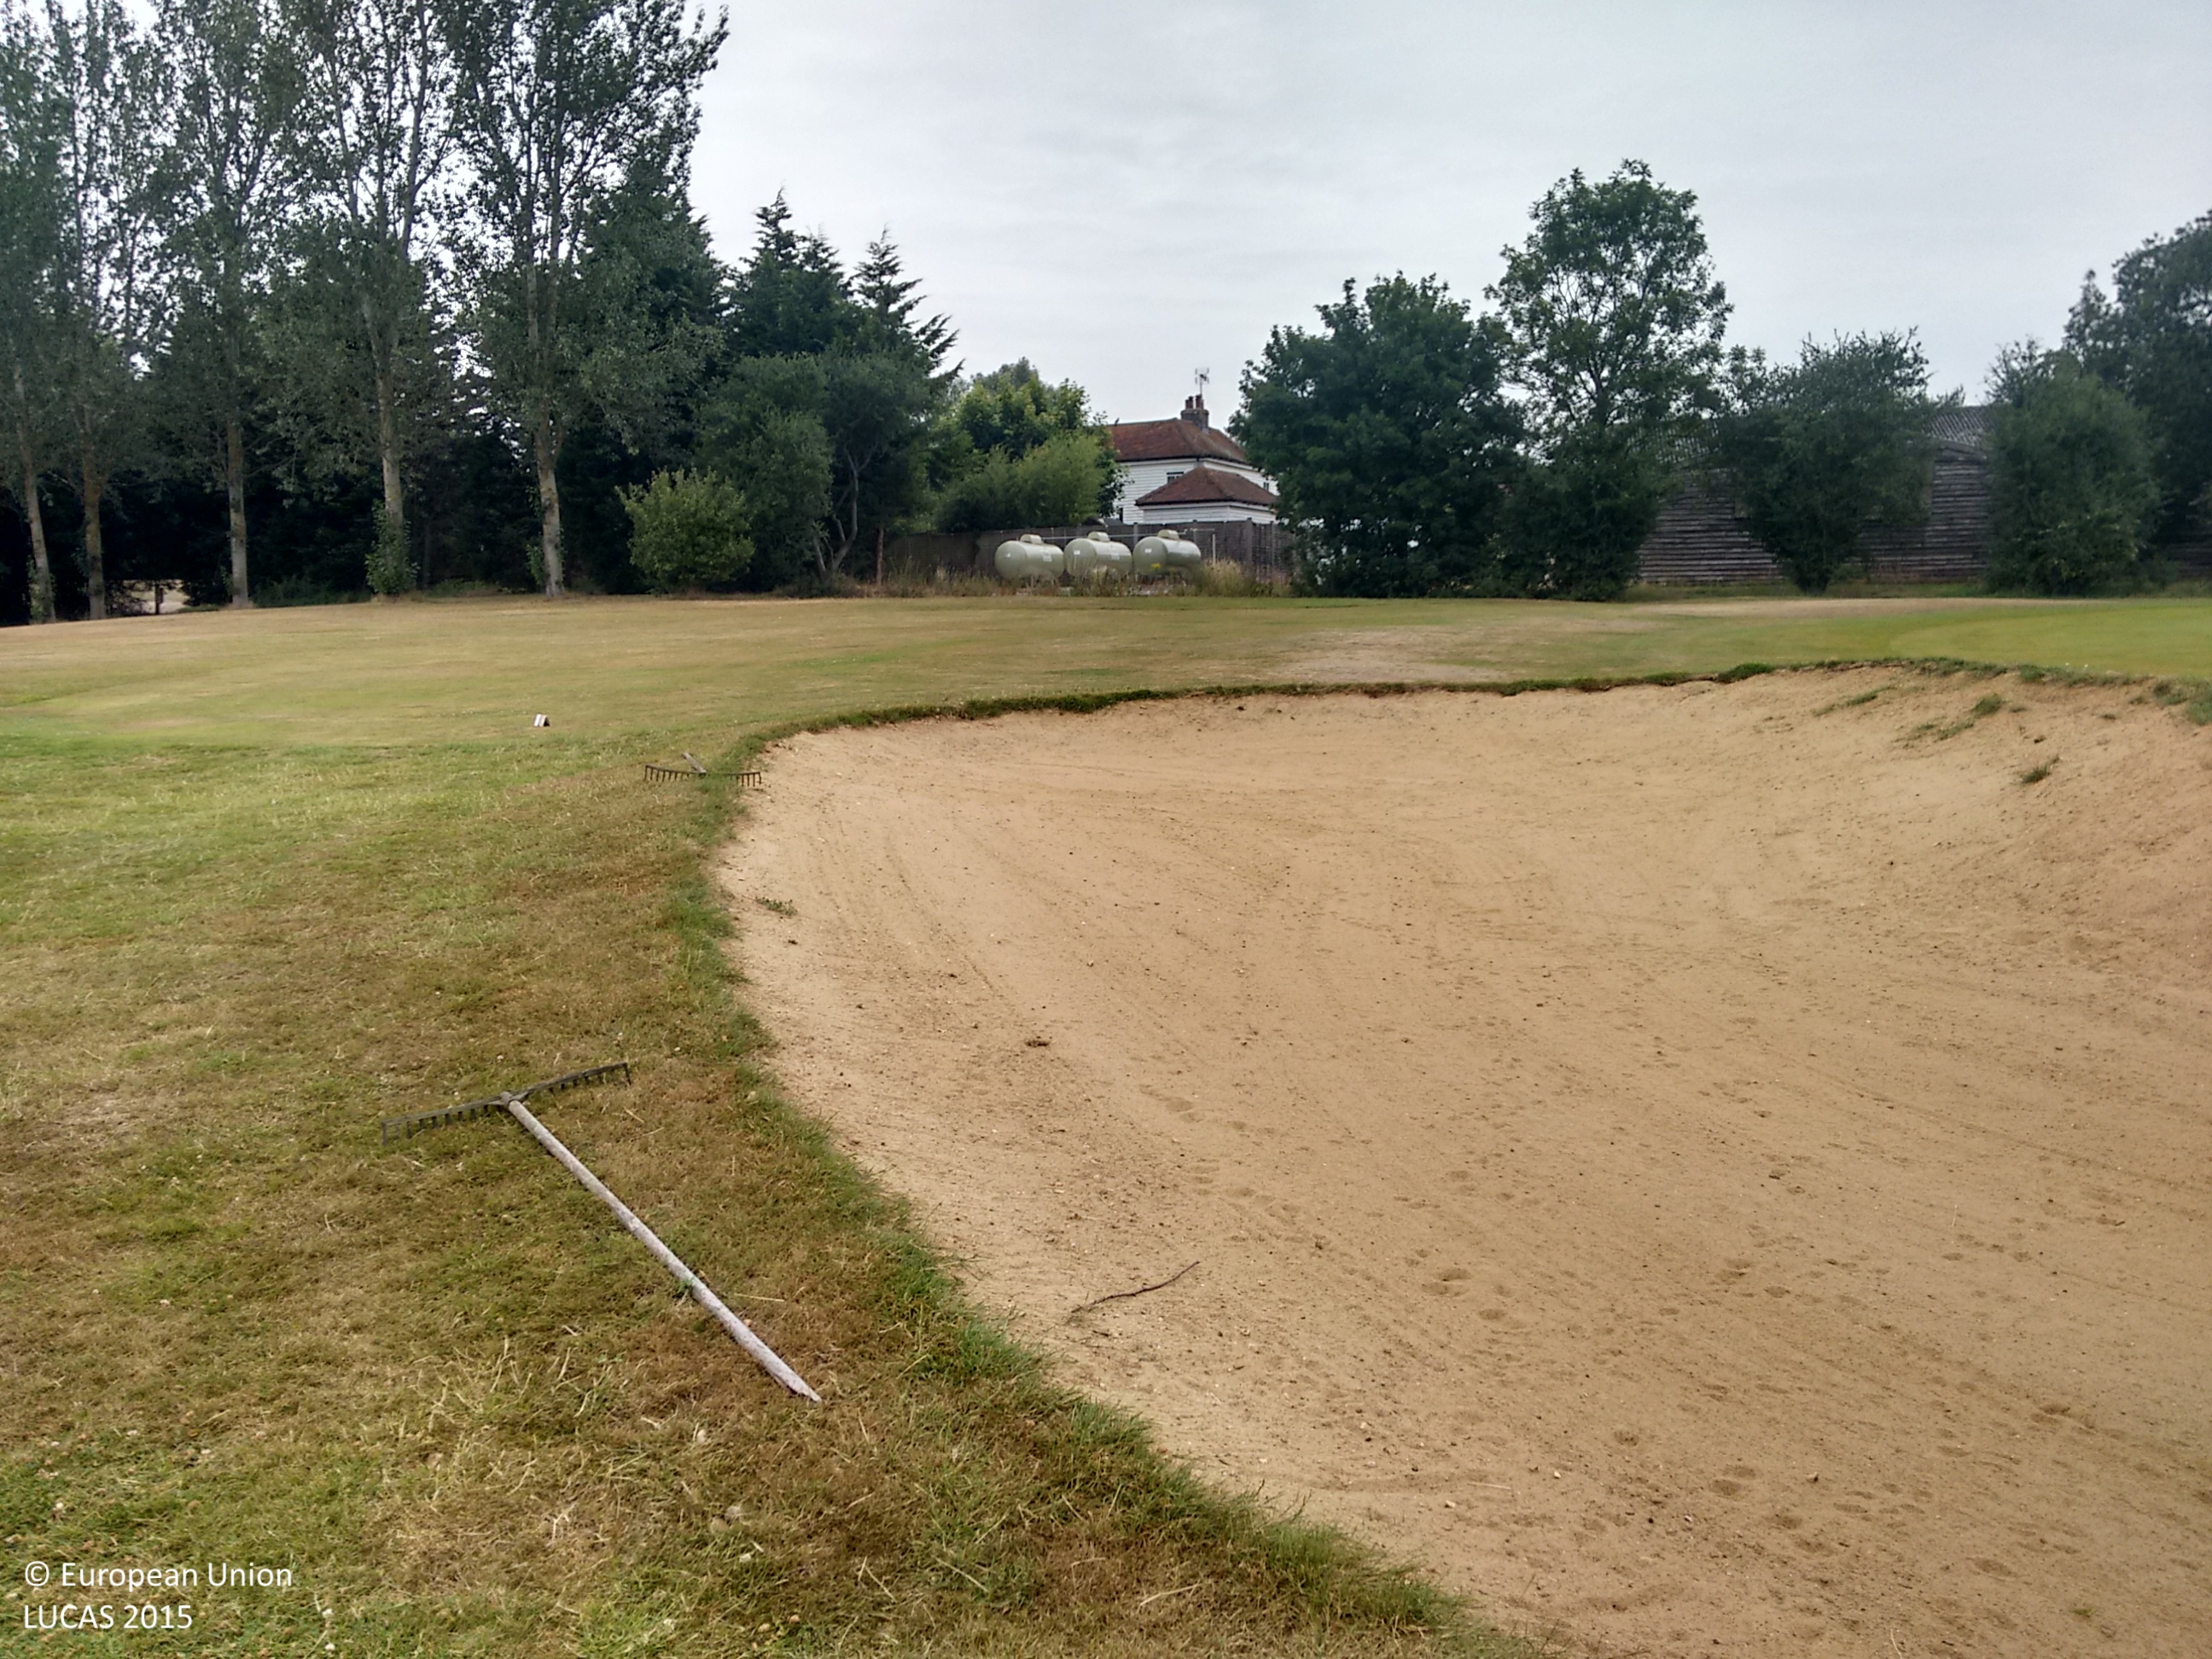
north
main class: Grassland
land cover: Grassland without tree/shrub cover
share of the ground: > 75 %
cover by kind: herbaceous plants 100 %
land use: Sport
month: July
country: GB
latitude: 51.7326
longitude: 0.6049
